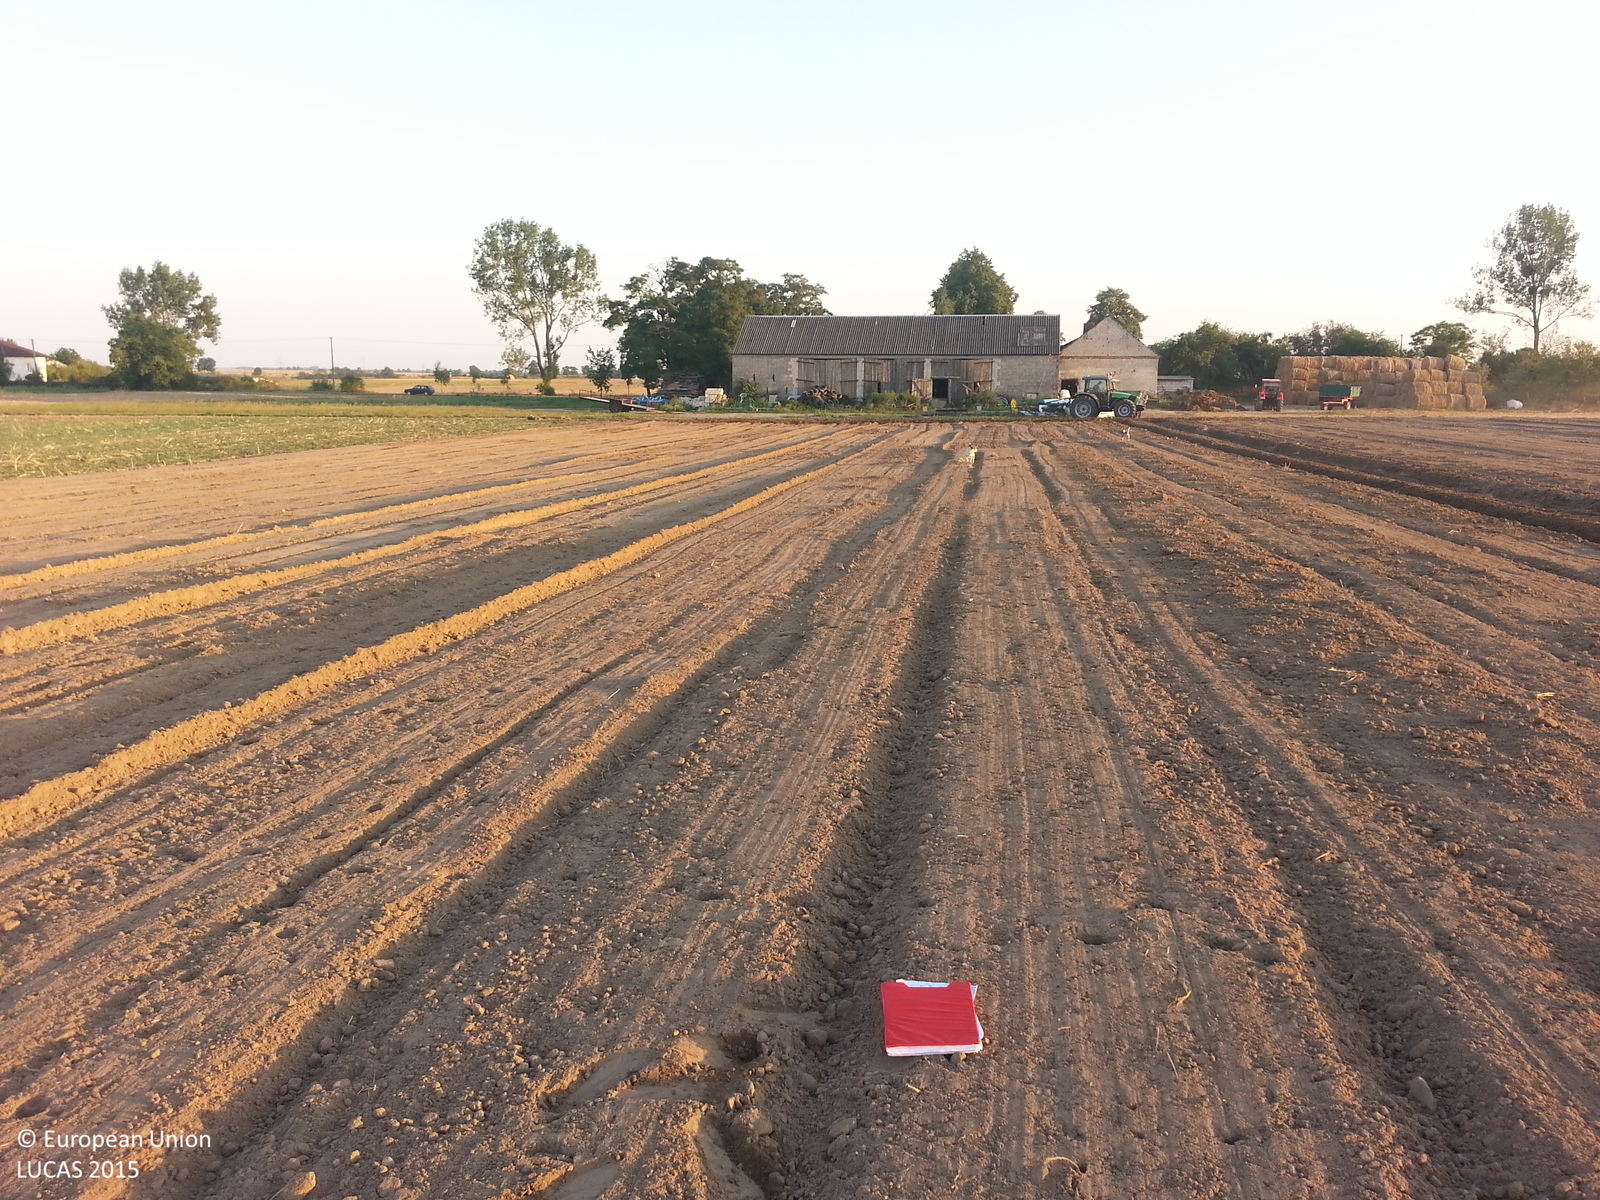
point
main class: Cropland
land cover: Barley
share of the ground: < 10 %
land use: Agriculture (excluding fallow land and kitchen gardens)
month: August
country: PL
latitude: 52.7357
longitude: 18.0577
